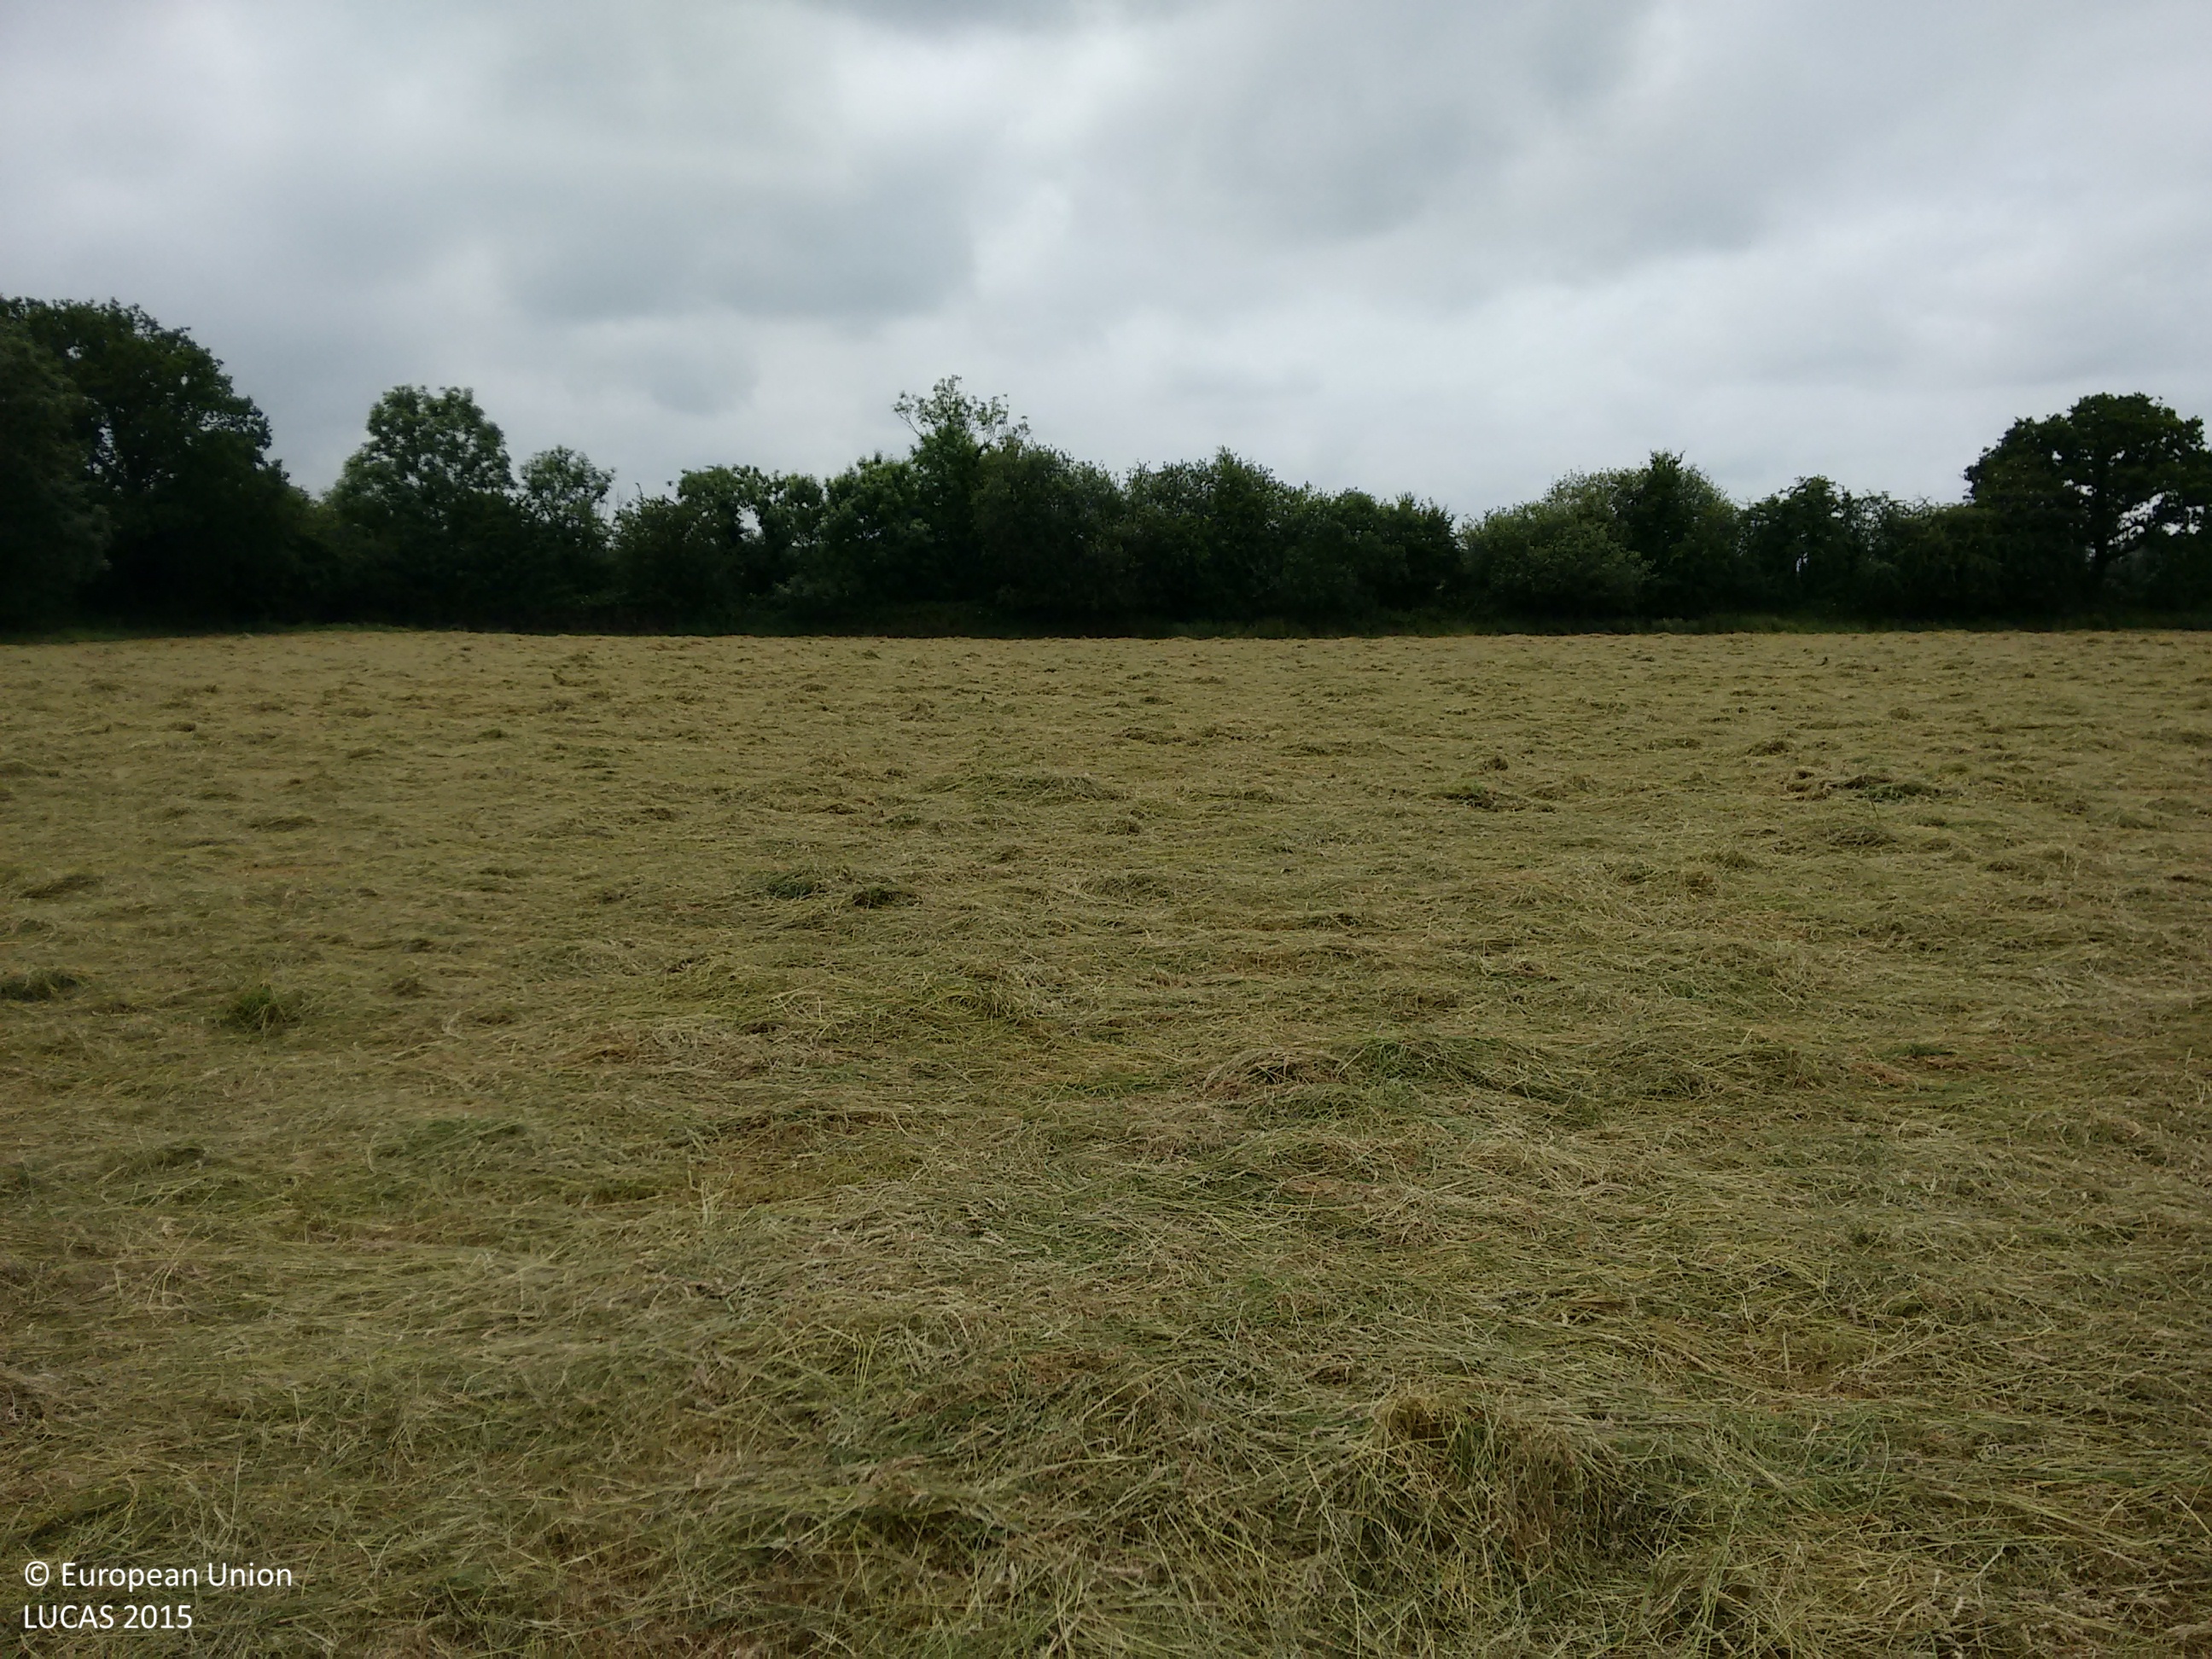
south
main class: Grassland
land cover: Grassland without tree/shrub cover
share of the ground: > 75 %
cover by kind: herbaceous plants 100 %
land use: Agriculture (excluding fallow land and kitchen gardens)
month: July
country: IE
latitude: 52.5433
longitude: -7.4537
